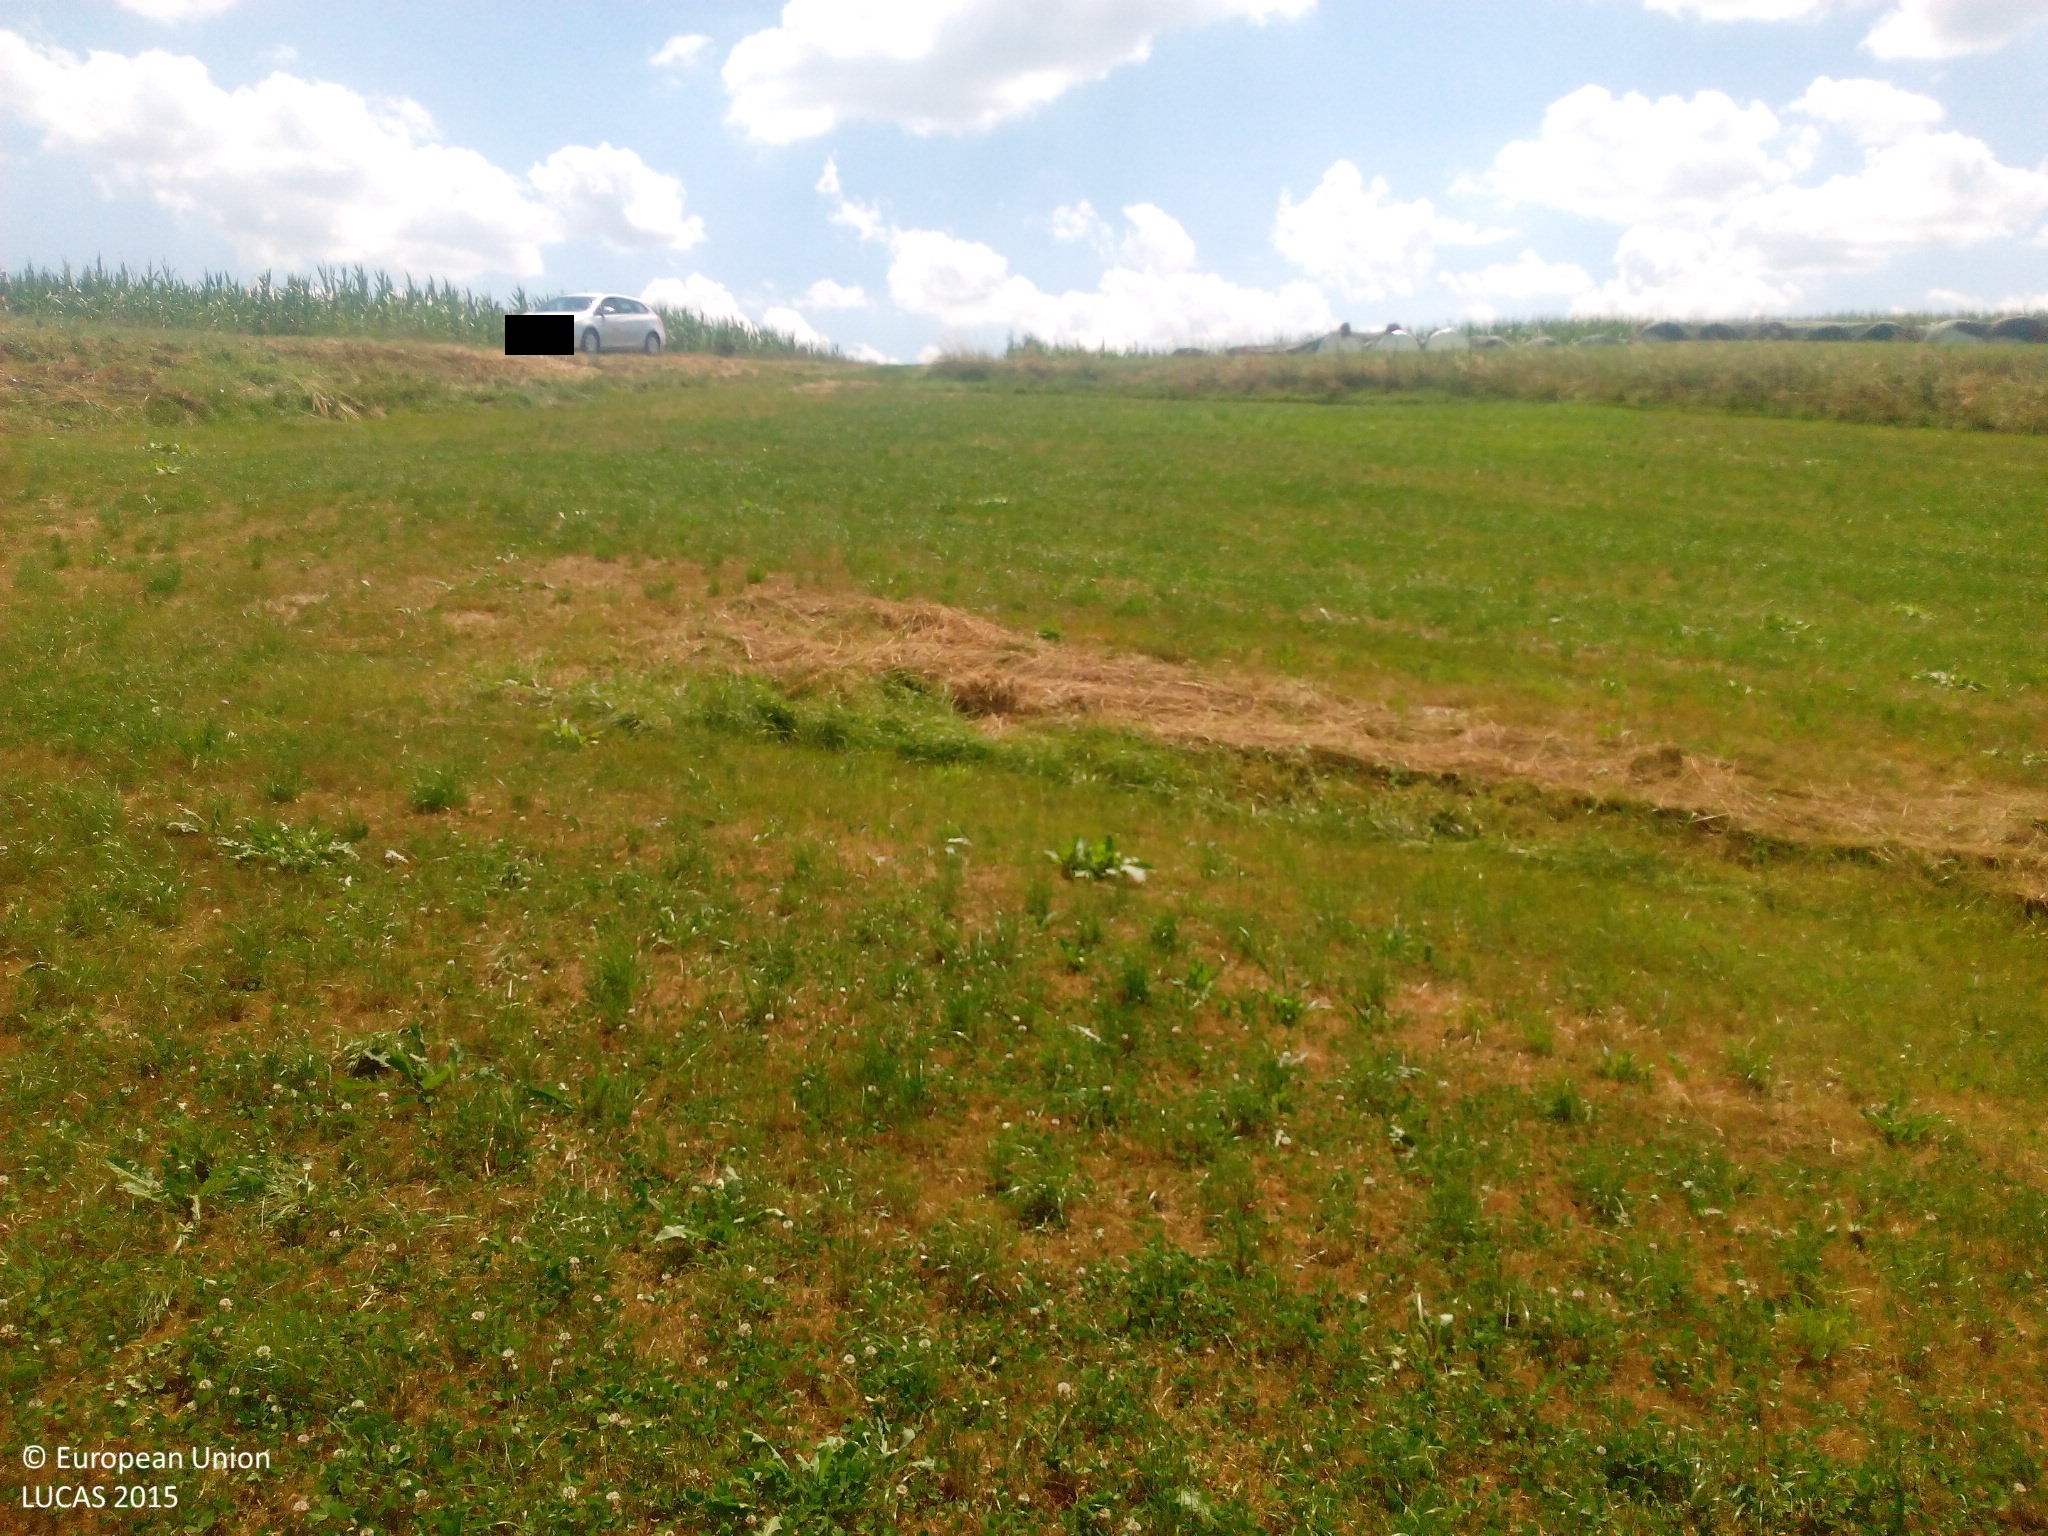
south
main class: Grassland
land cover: Grassland without tree/shrub cover
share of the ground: > 75 %
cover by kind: herbaceous plants 100 %
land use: Agriculture (excluding fallow land and kitchen gardens)
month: July
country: DE
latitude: 48.1859
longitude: 10.6049
